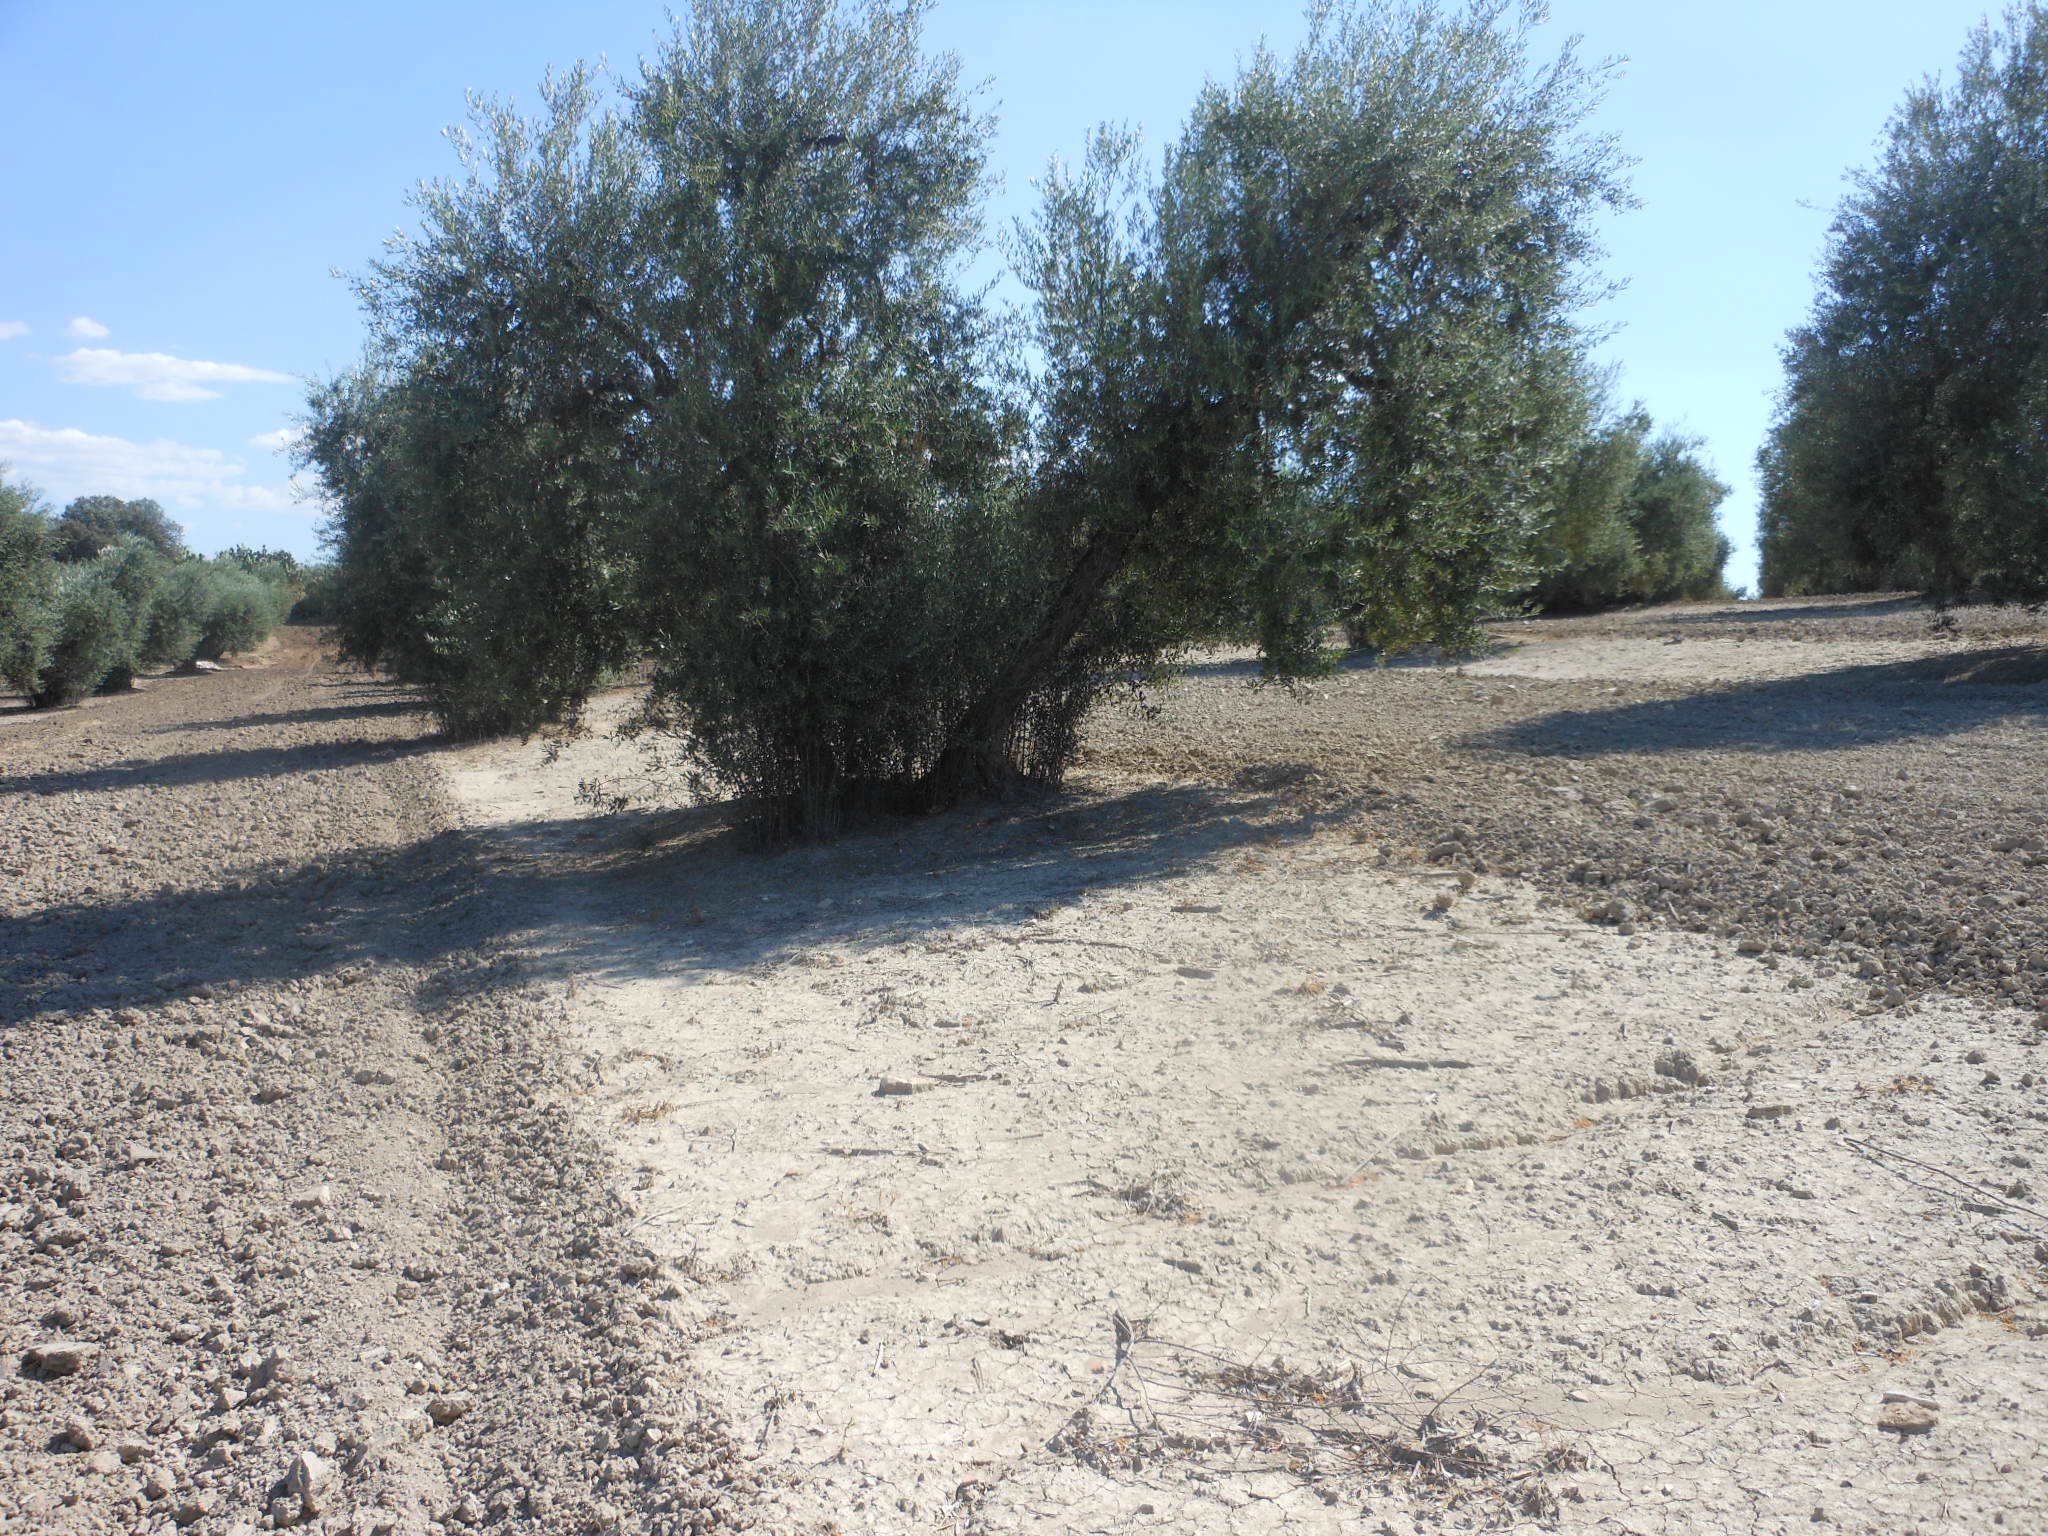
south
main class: Cropland
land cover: Olive groves
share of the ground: 25 - 50 %
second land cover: Other bare soil
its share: > 75 %
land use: Agriculture (excluding fallow land and kitchen gardens)
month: June
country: ES
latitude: 37.2148
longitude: -5.5532
